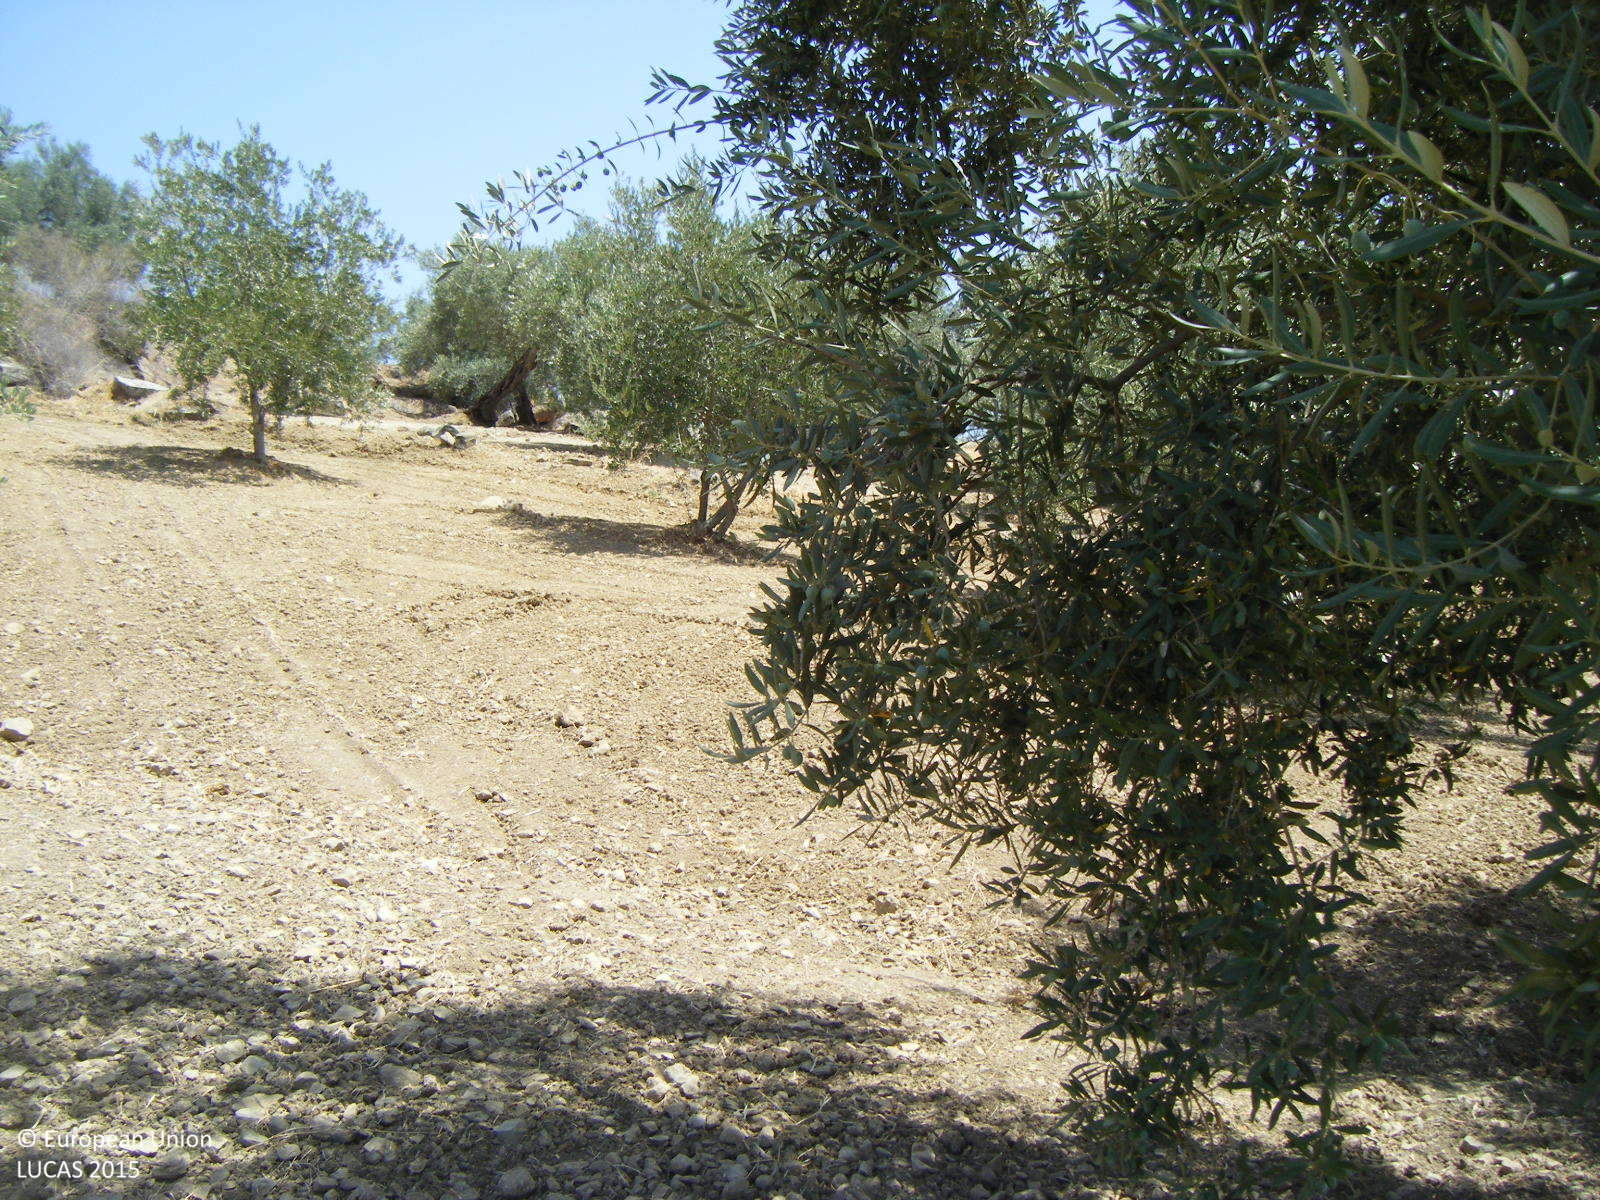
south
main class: Cropland
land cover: Olive groves
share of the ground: 10 - 25 %
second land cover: Other bare soil
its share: > 75 %
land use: Agriculture (excluding fallow land and kitchen gardens)
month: July
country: ES
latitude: 36.9243
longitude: -4.2598
